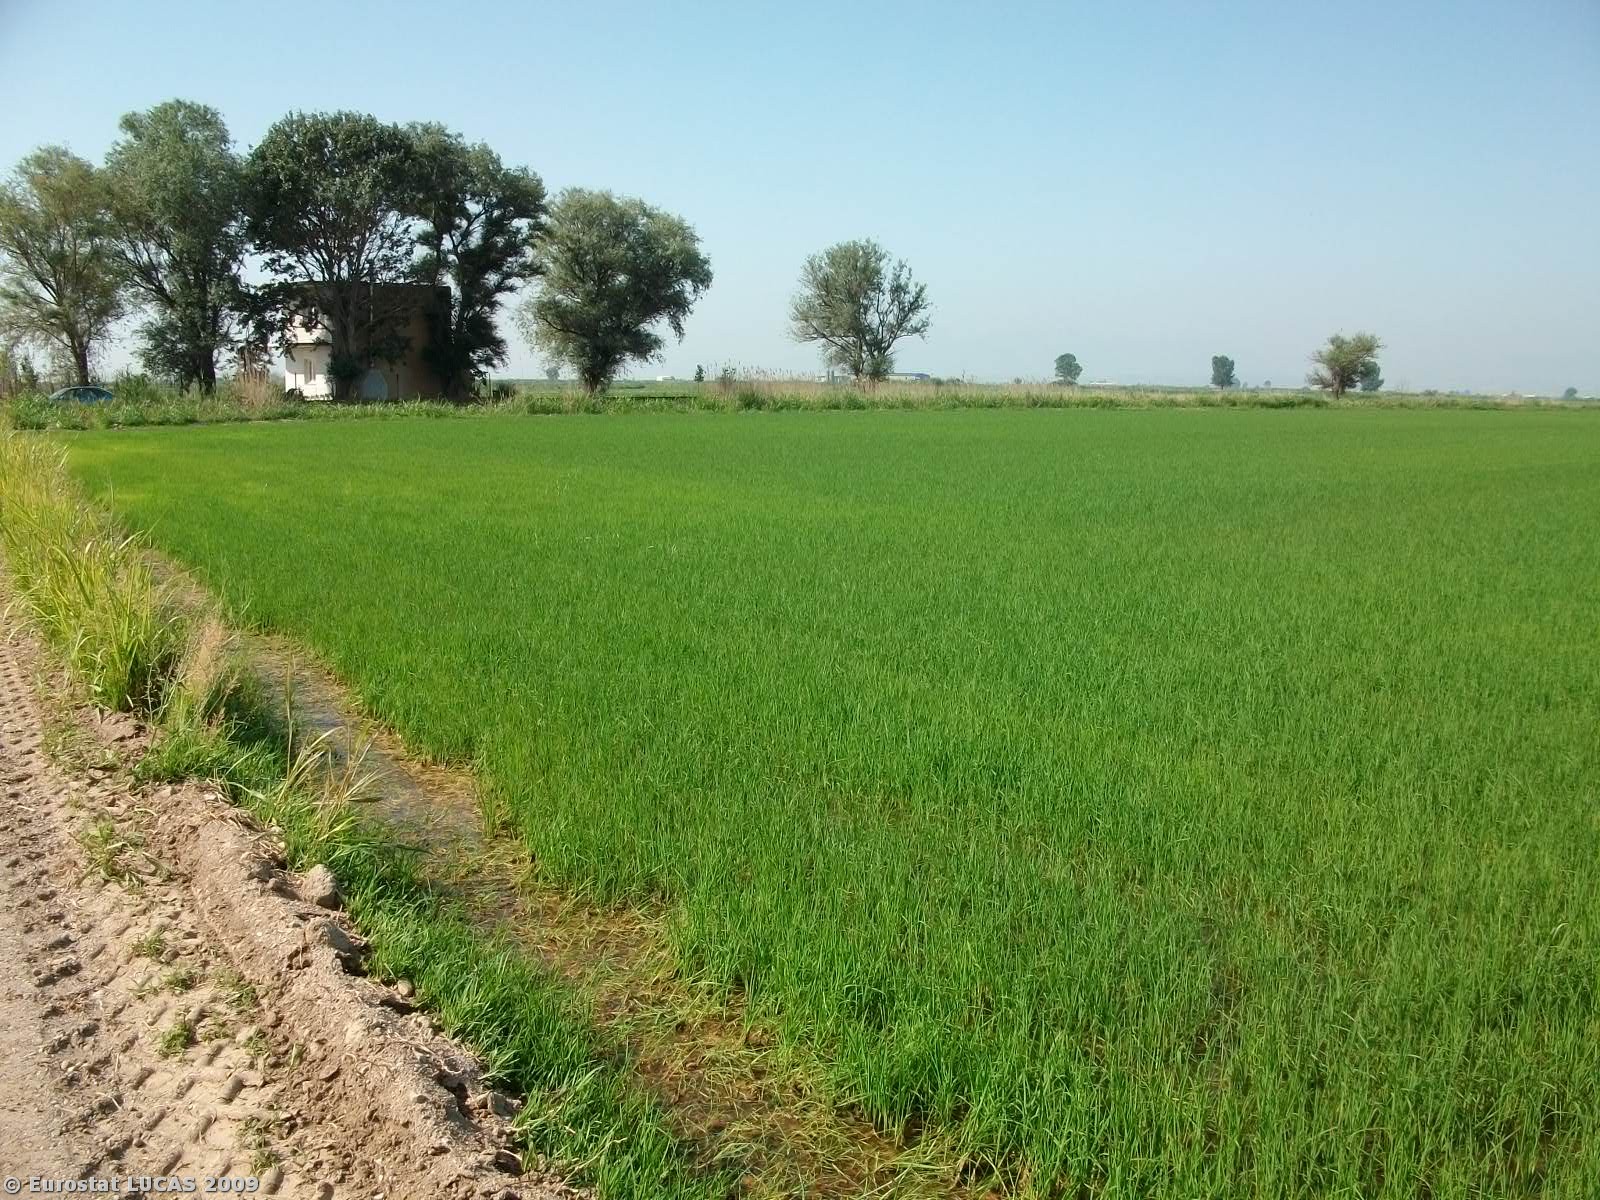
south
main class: Cropland
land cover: Rice
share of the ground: > 75 %
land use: Agriculture (excluding fallow land and kitchen gardens)
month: June
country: GR
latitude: 40.6135
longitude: 22.6627
